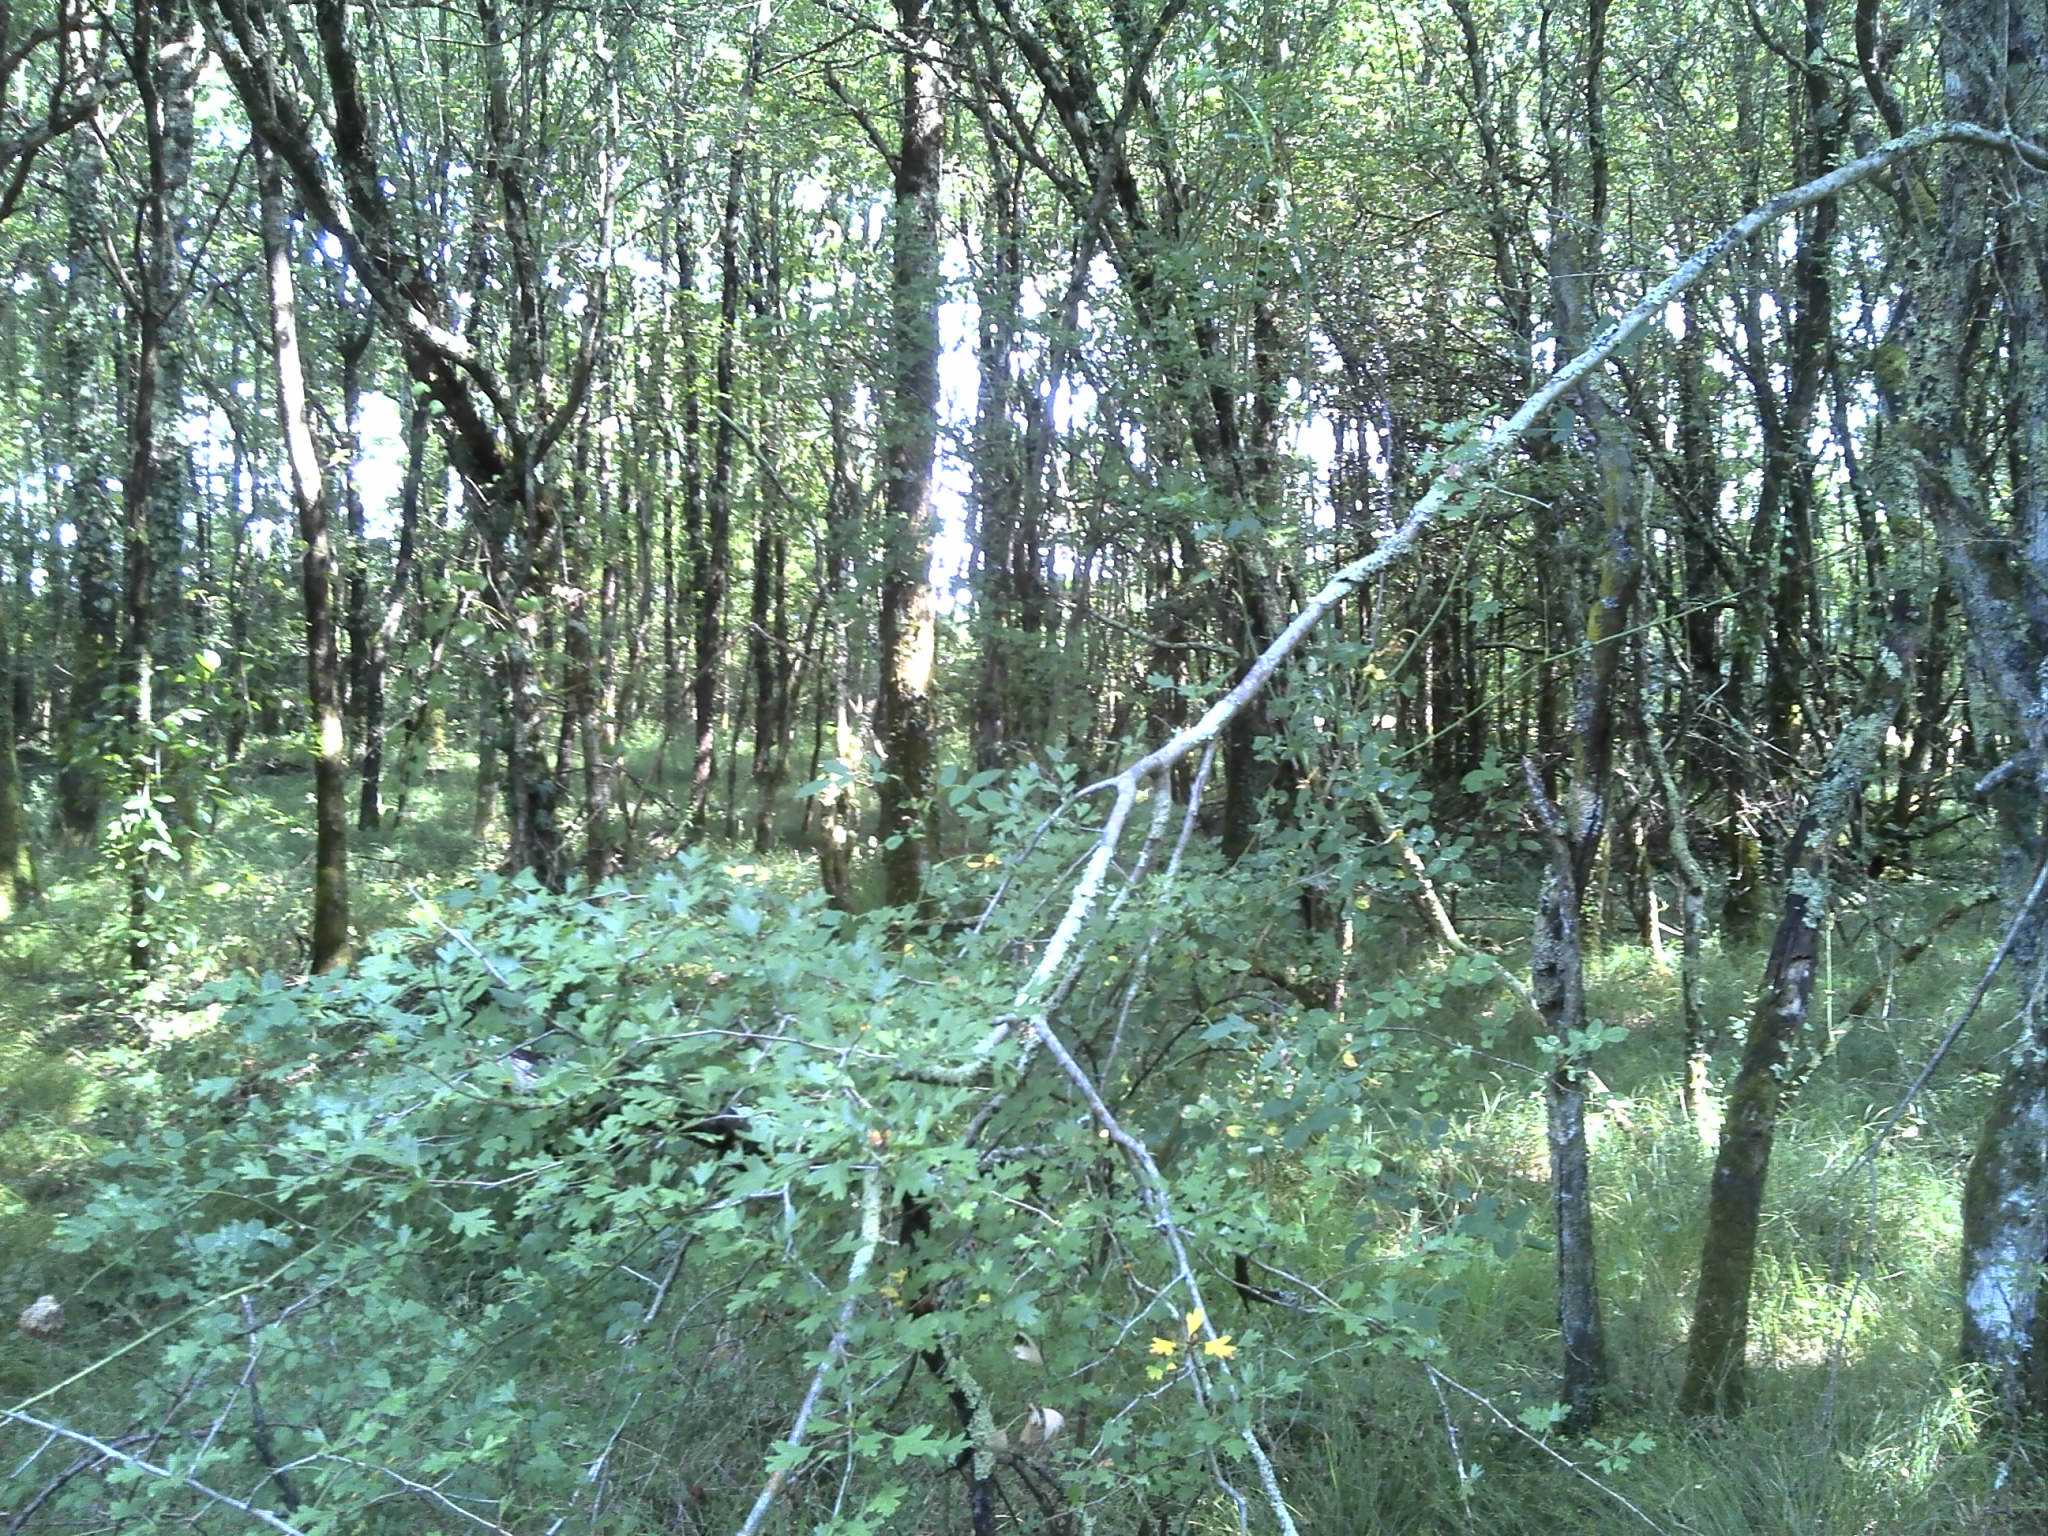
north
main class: Woodland
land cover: Broadleaved woodland
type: mesophytic deciduous forest
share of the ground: > 75 %
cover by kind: broadleaved forest trees 95 %, herbaceous plants 5 %
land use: Forestry
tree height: > 5 m
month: July
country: FR
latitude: 46.6867
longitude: 1.5560
